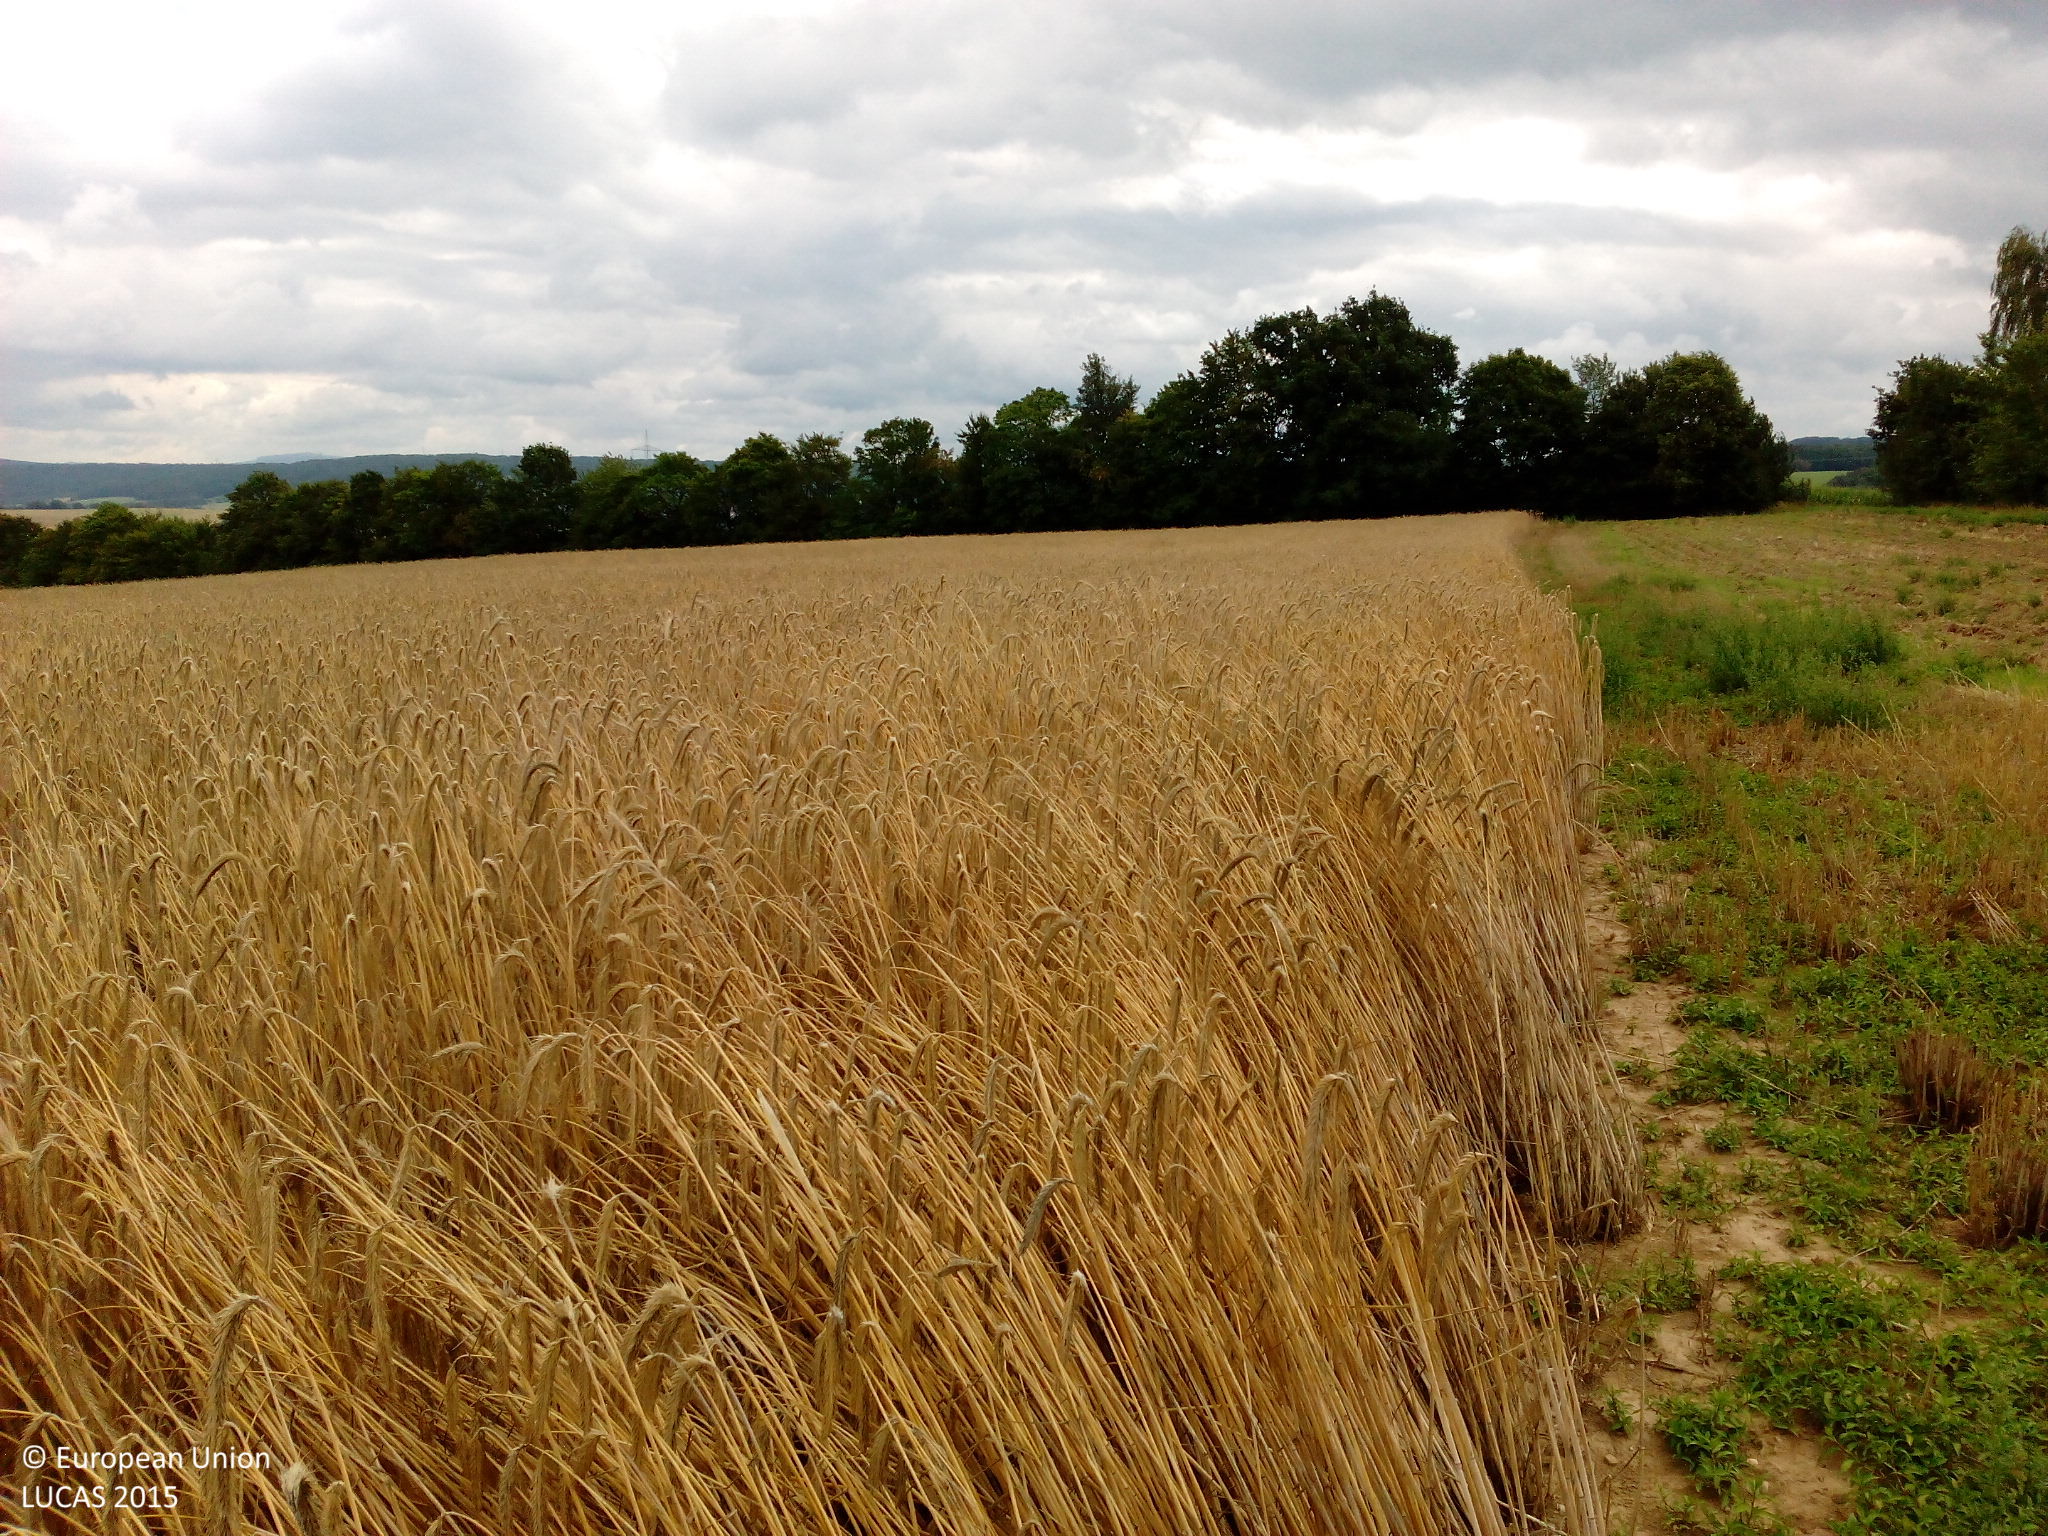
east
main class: Cropland
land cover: Triticale
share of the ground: > 75 %
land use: Agriculture (excluding fallow land and kitchen gardens)
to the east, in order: Triticale; Grass margins; Broadleaved woodland; Tracks; Grass margins; Maize
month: July
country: DE
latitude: 50.4173
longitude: 9.5920
